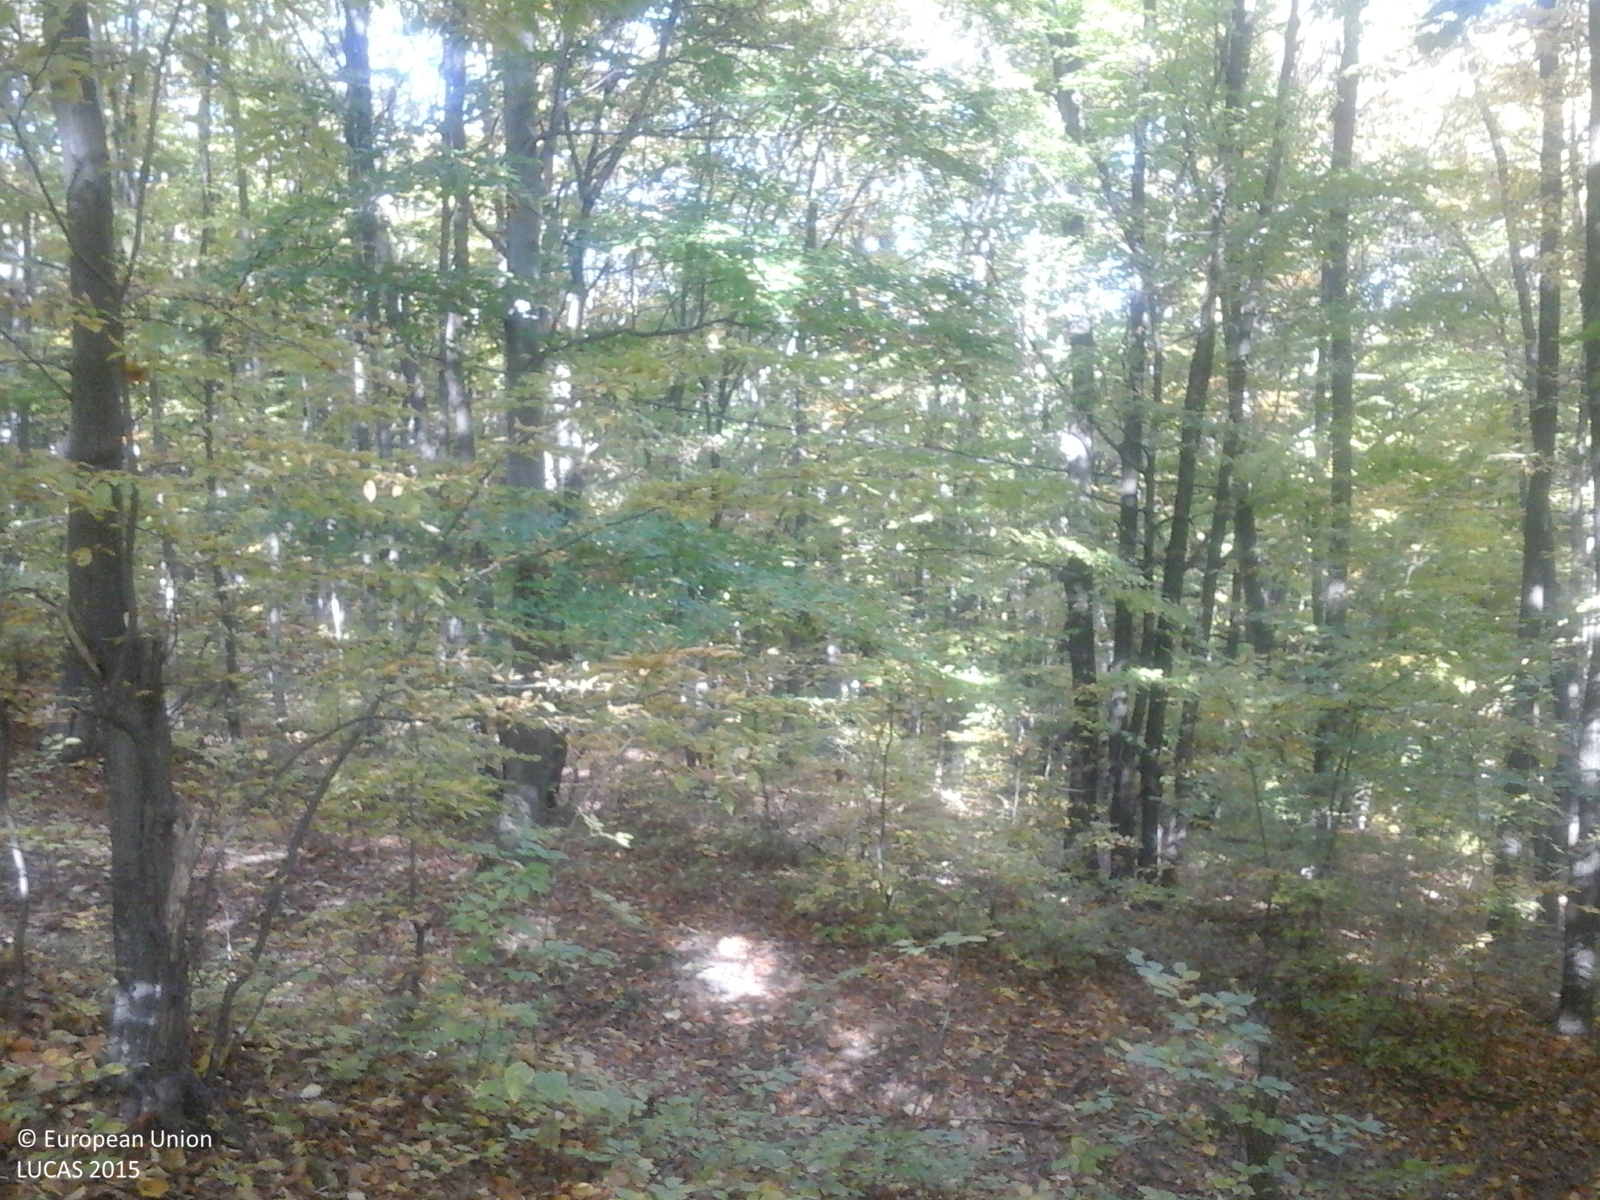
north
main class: Woodland
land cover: Broadleaved woodland
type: beech forest
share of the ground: > 75 %
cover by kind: broadleaved forest trees 100 %
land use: Forestry
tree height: > 5 m
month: October
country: RO
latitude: 45.2352
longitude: 26.5436
